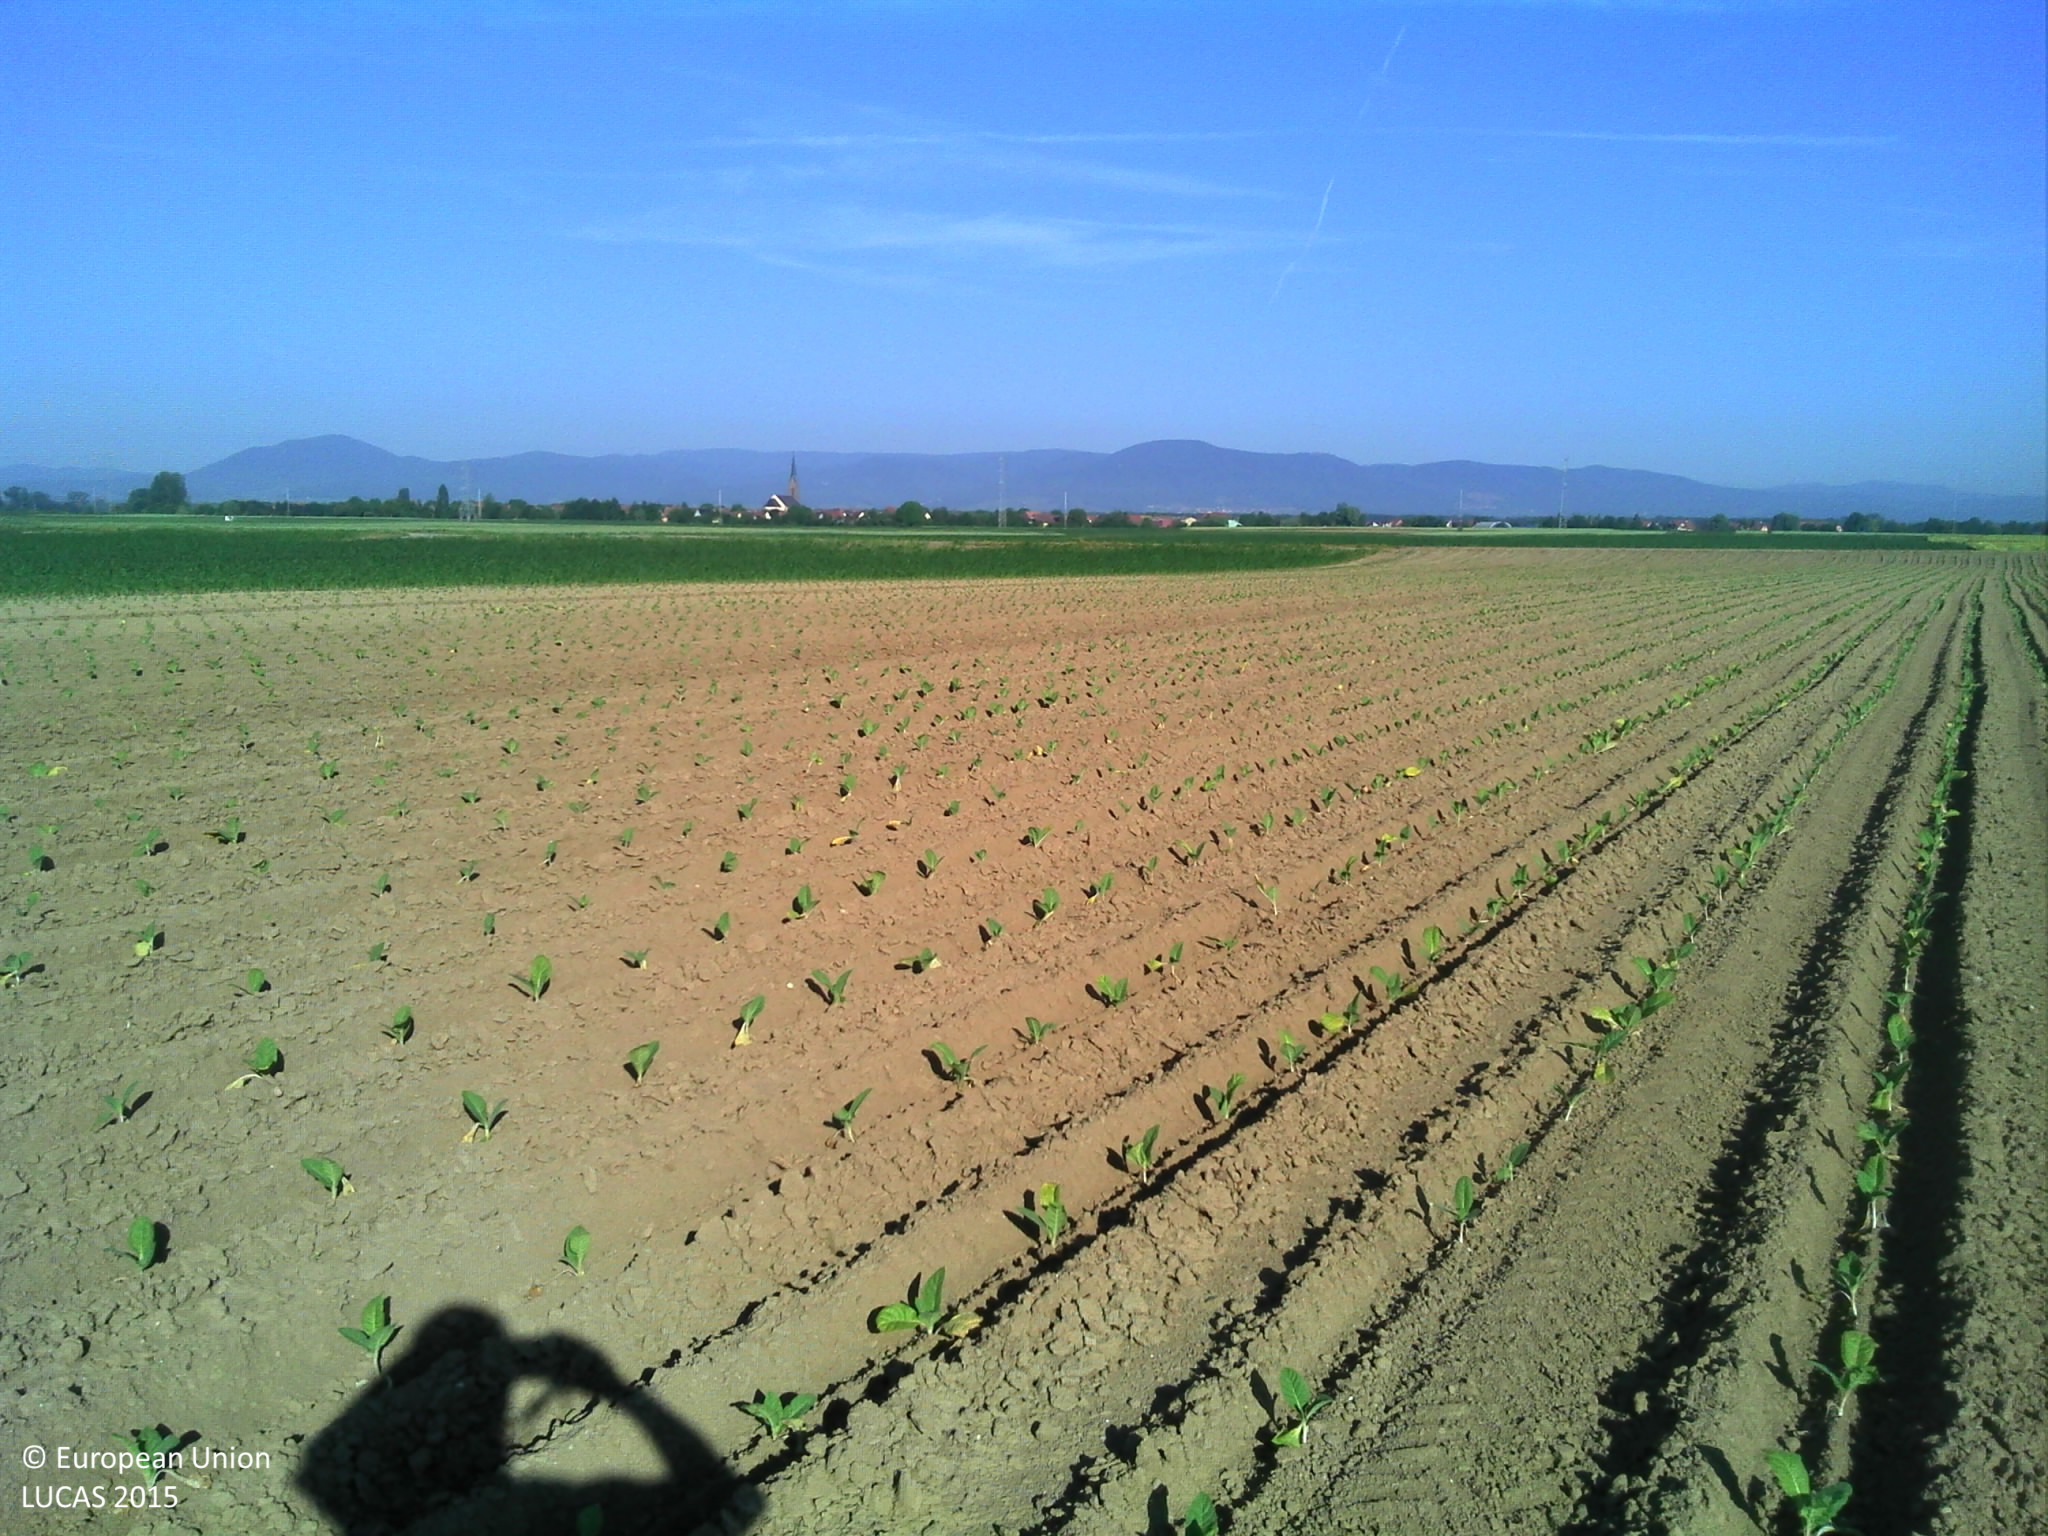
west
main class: Cropland
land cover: Tobacco
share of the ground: 10 - 25 %
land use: Agriculture (excluding fallow land and kitchen gardens)
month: June
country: FR
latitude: 48.3957
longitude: 7.6104
